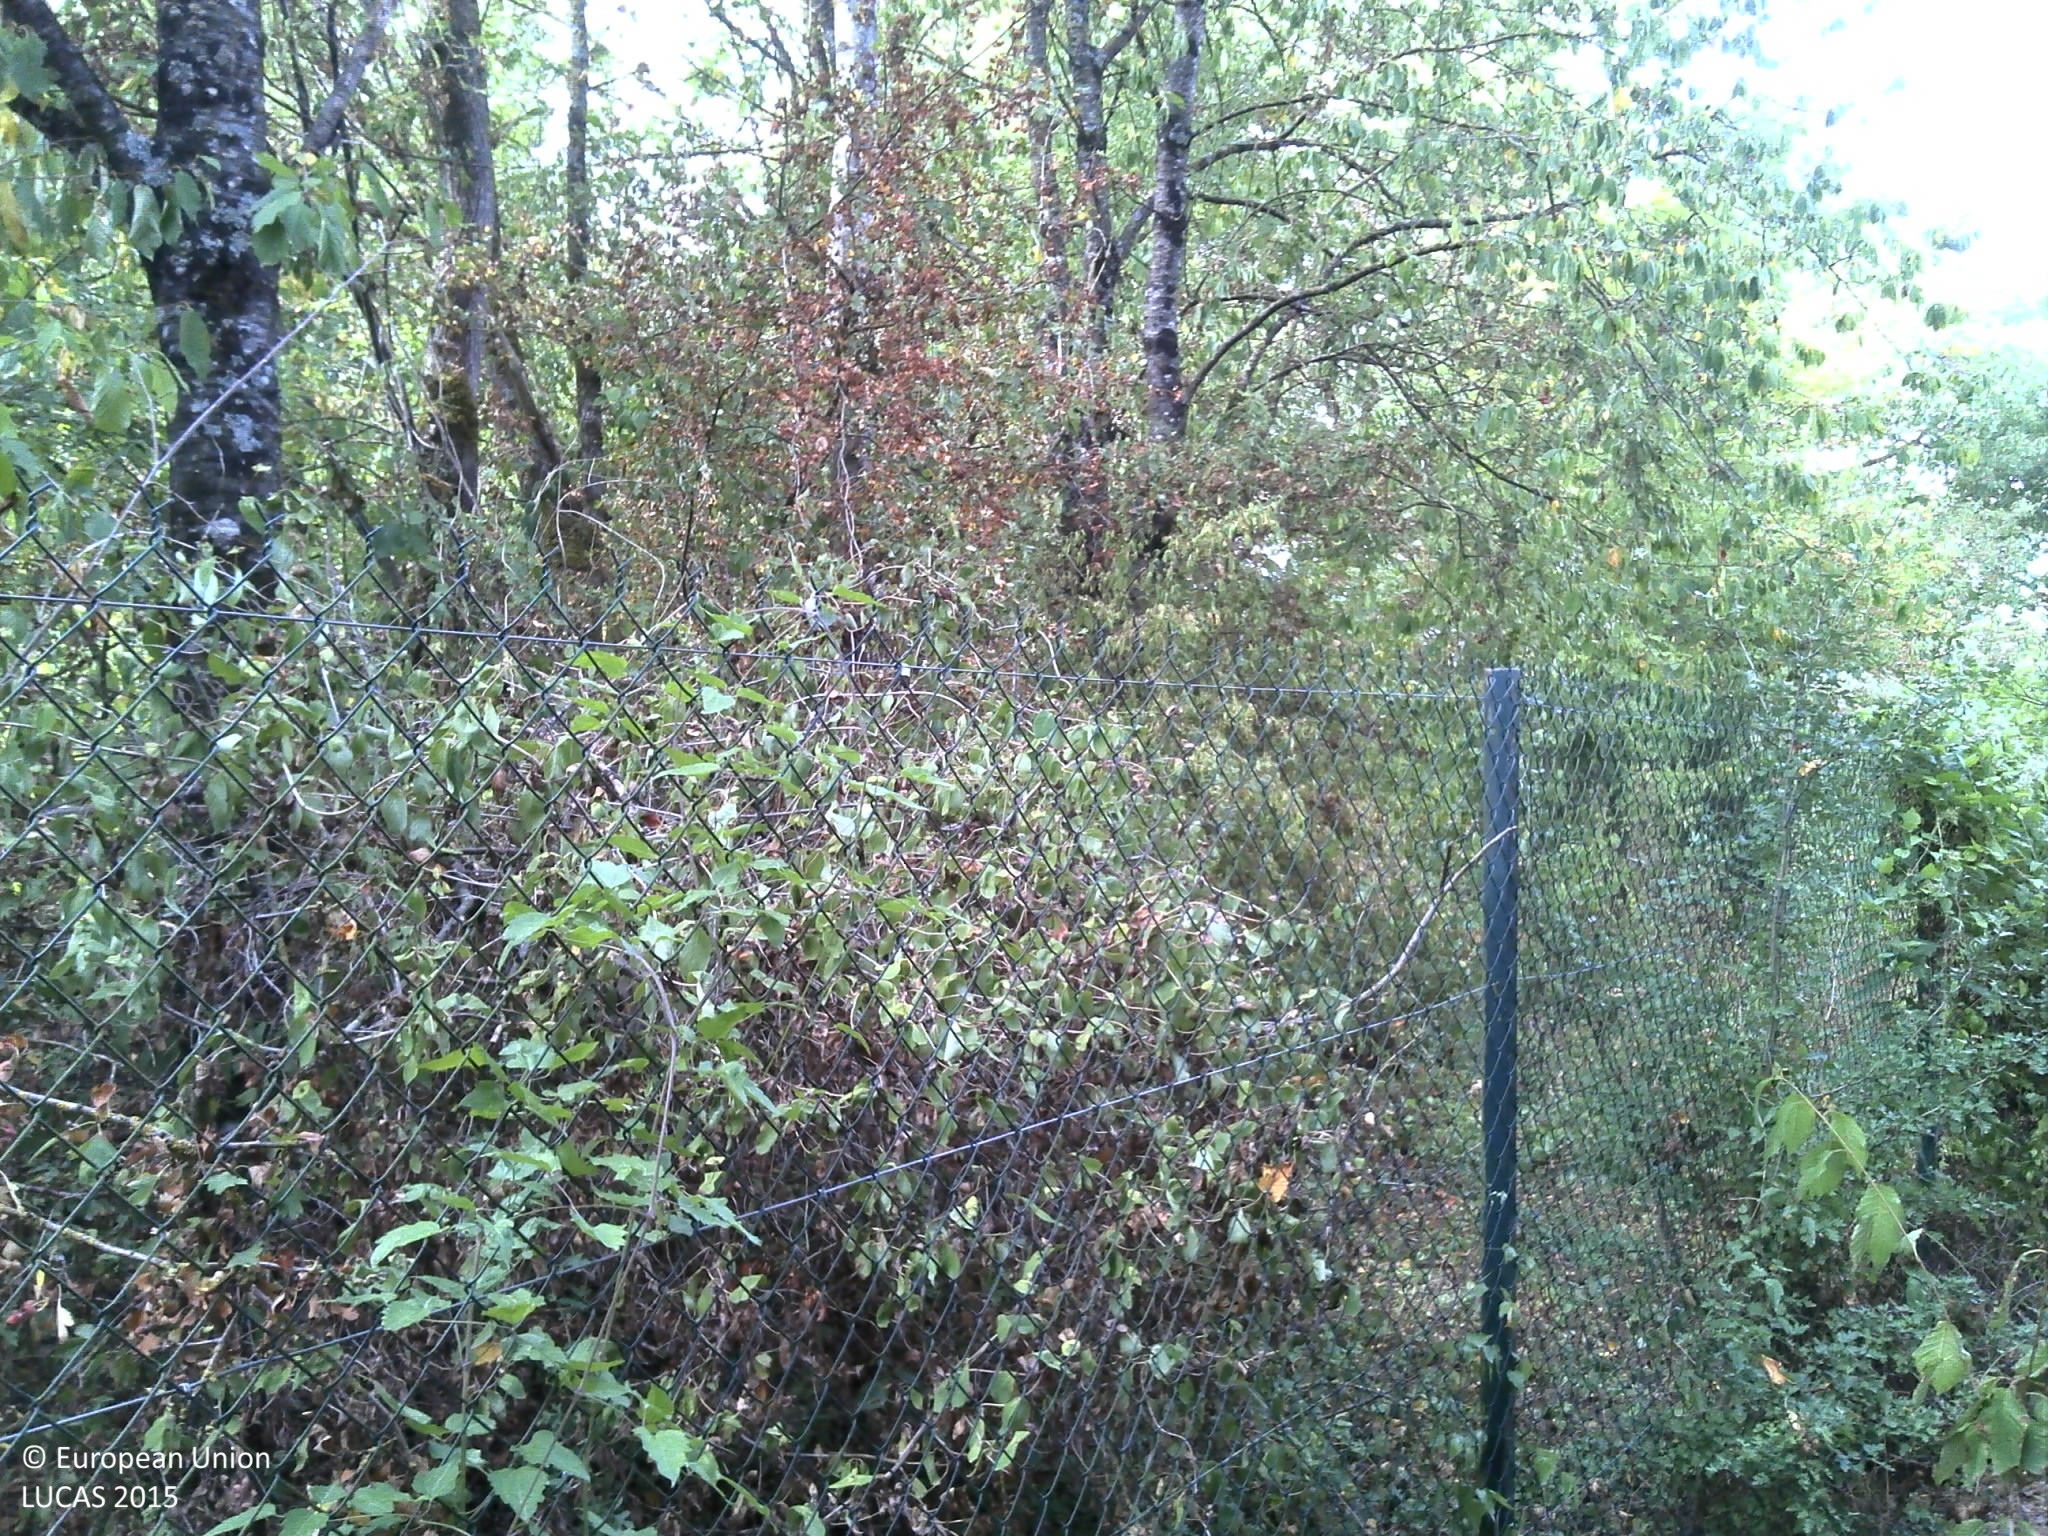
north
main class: Grassland
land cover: Grassland without tree/shrub cover
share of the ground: > 75 %
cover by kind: herbaceous plants 100 %
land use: Amenities, museums, leisure
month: August
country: FR
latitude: 48.5406
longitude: 4.2129
